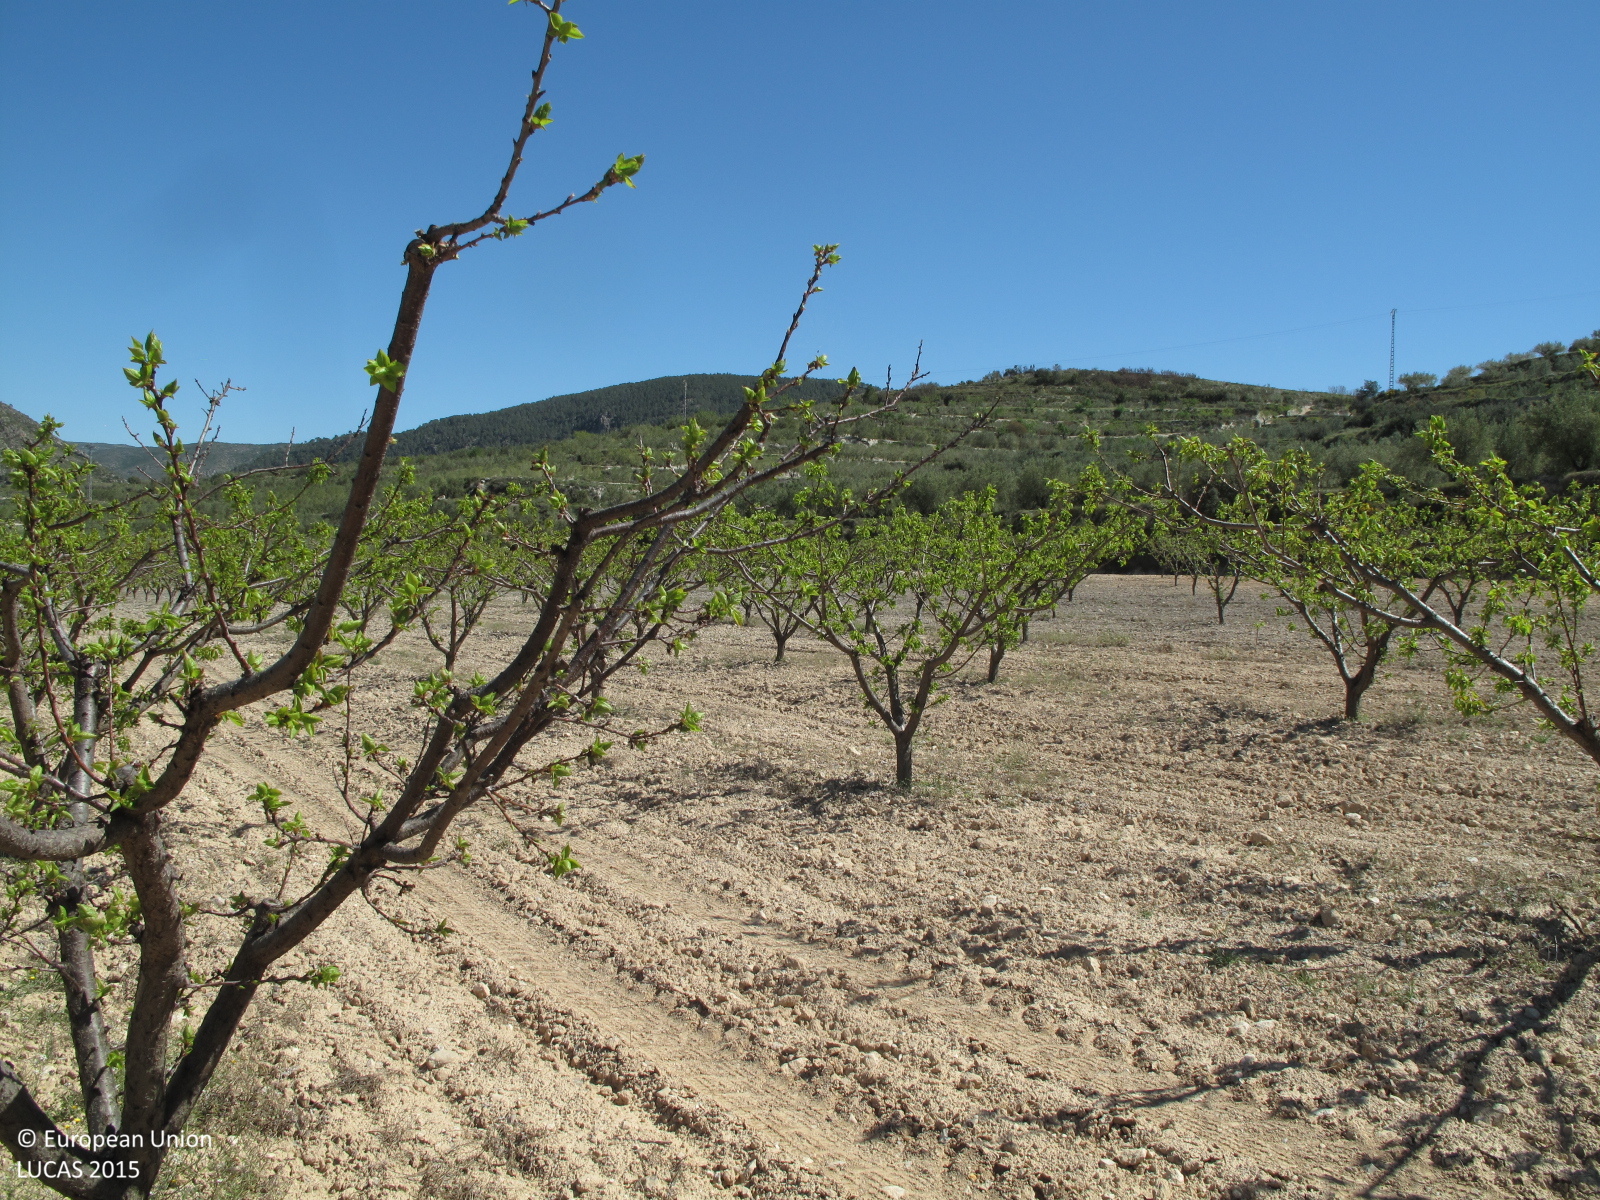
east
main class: Cropland
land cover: Other fruit trees and berries
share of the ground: 25 - 50 %
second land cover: Other bare soil
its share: > 75 %
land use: Agriculture (excluding fallow land and kitchen gardens)
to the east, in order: Other fruit trees and berries; Other bare soil; Grass margins; Tracks; Grass margins; Olive groves; Grass margins; Olive groves; Grass margins; Olive groves
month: March
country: ES
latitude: 38.8494
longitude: -0.7888
